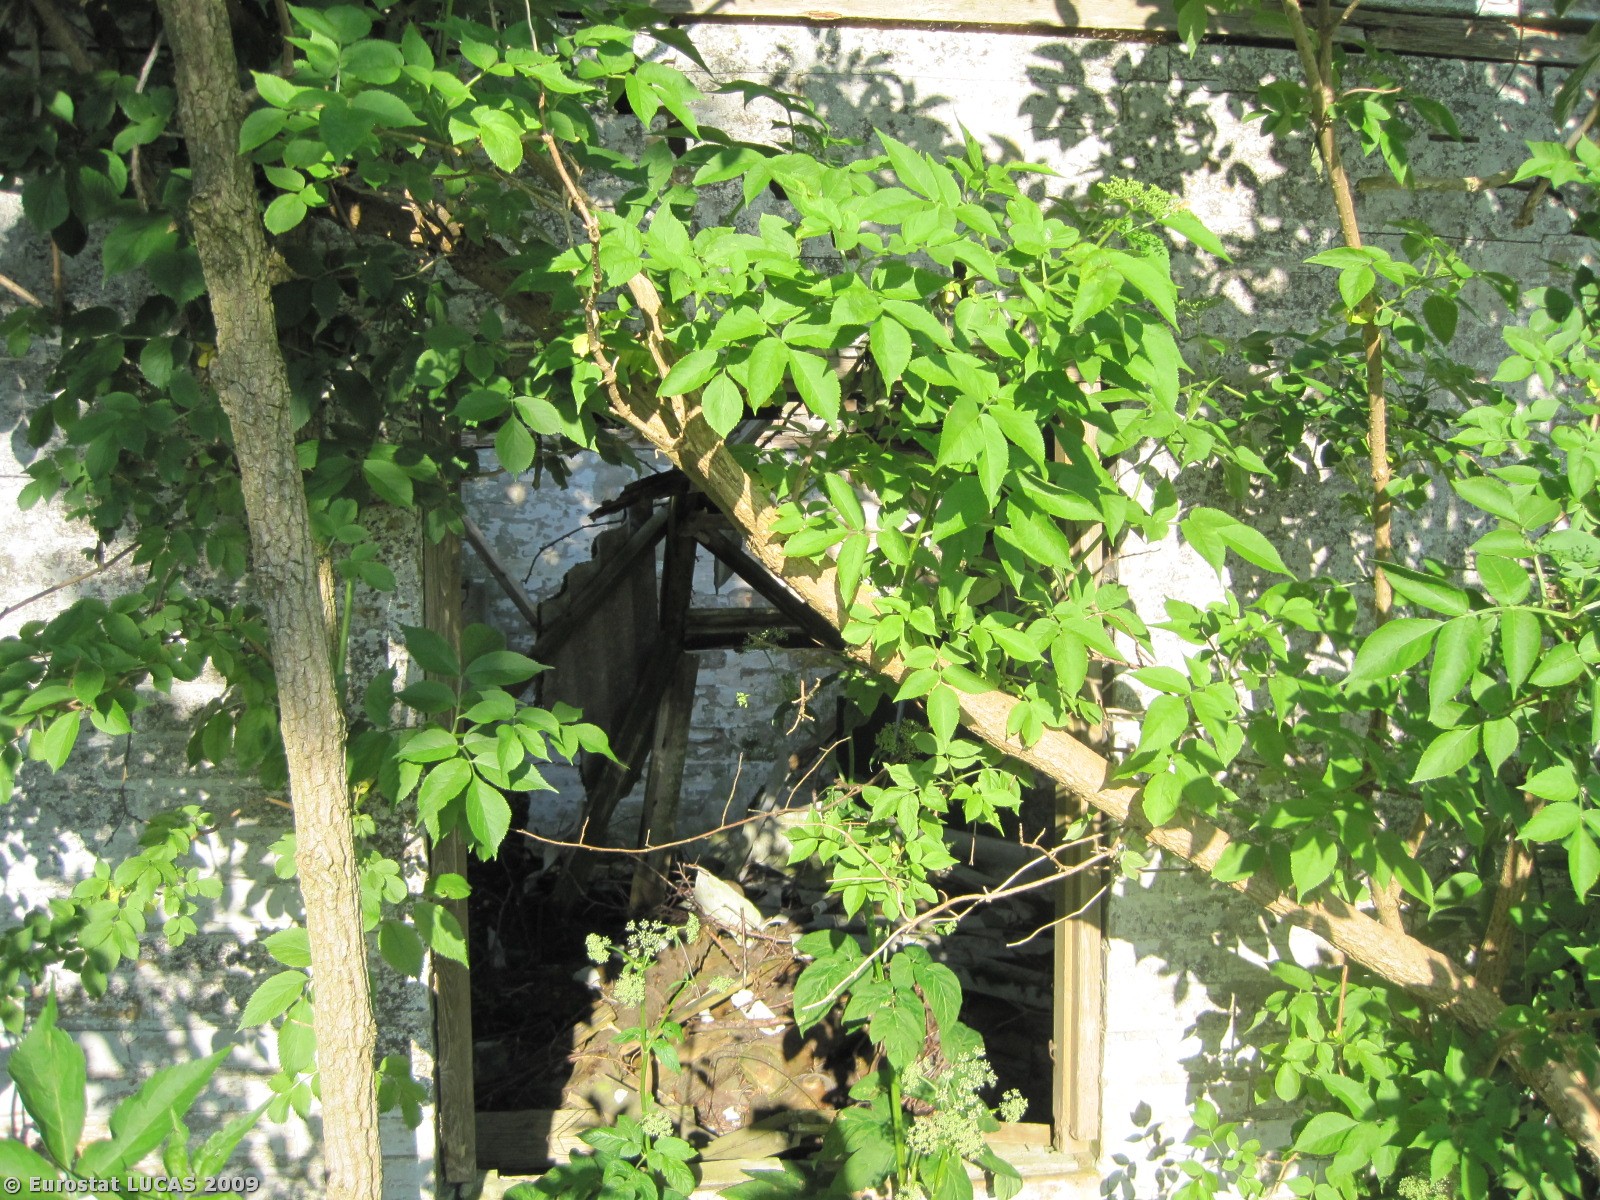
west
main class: Woodland
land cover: Broadleaved woodland
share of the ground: > 75 %
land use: Residential
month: June
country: DK
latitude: 57.4821
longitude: 9.8834
